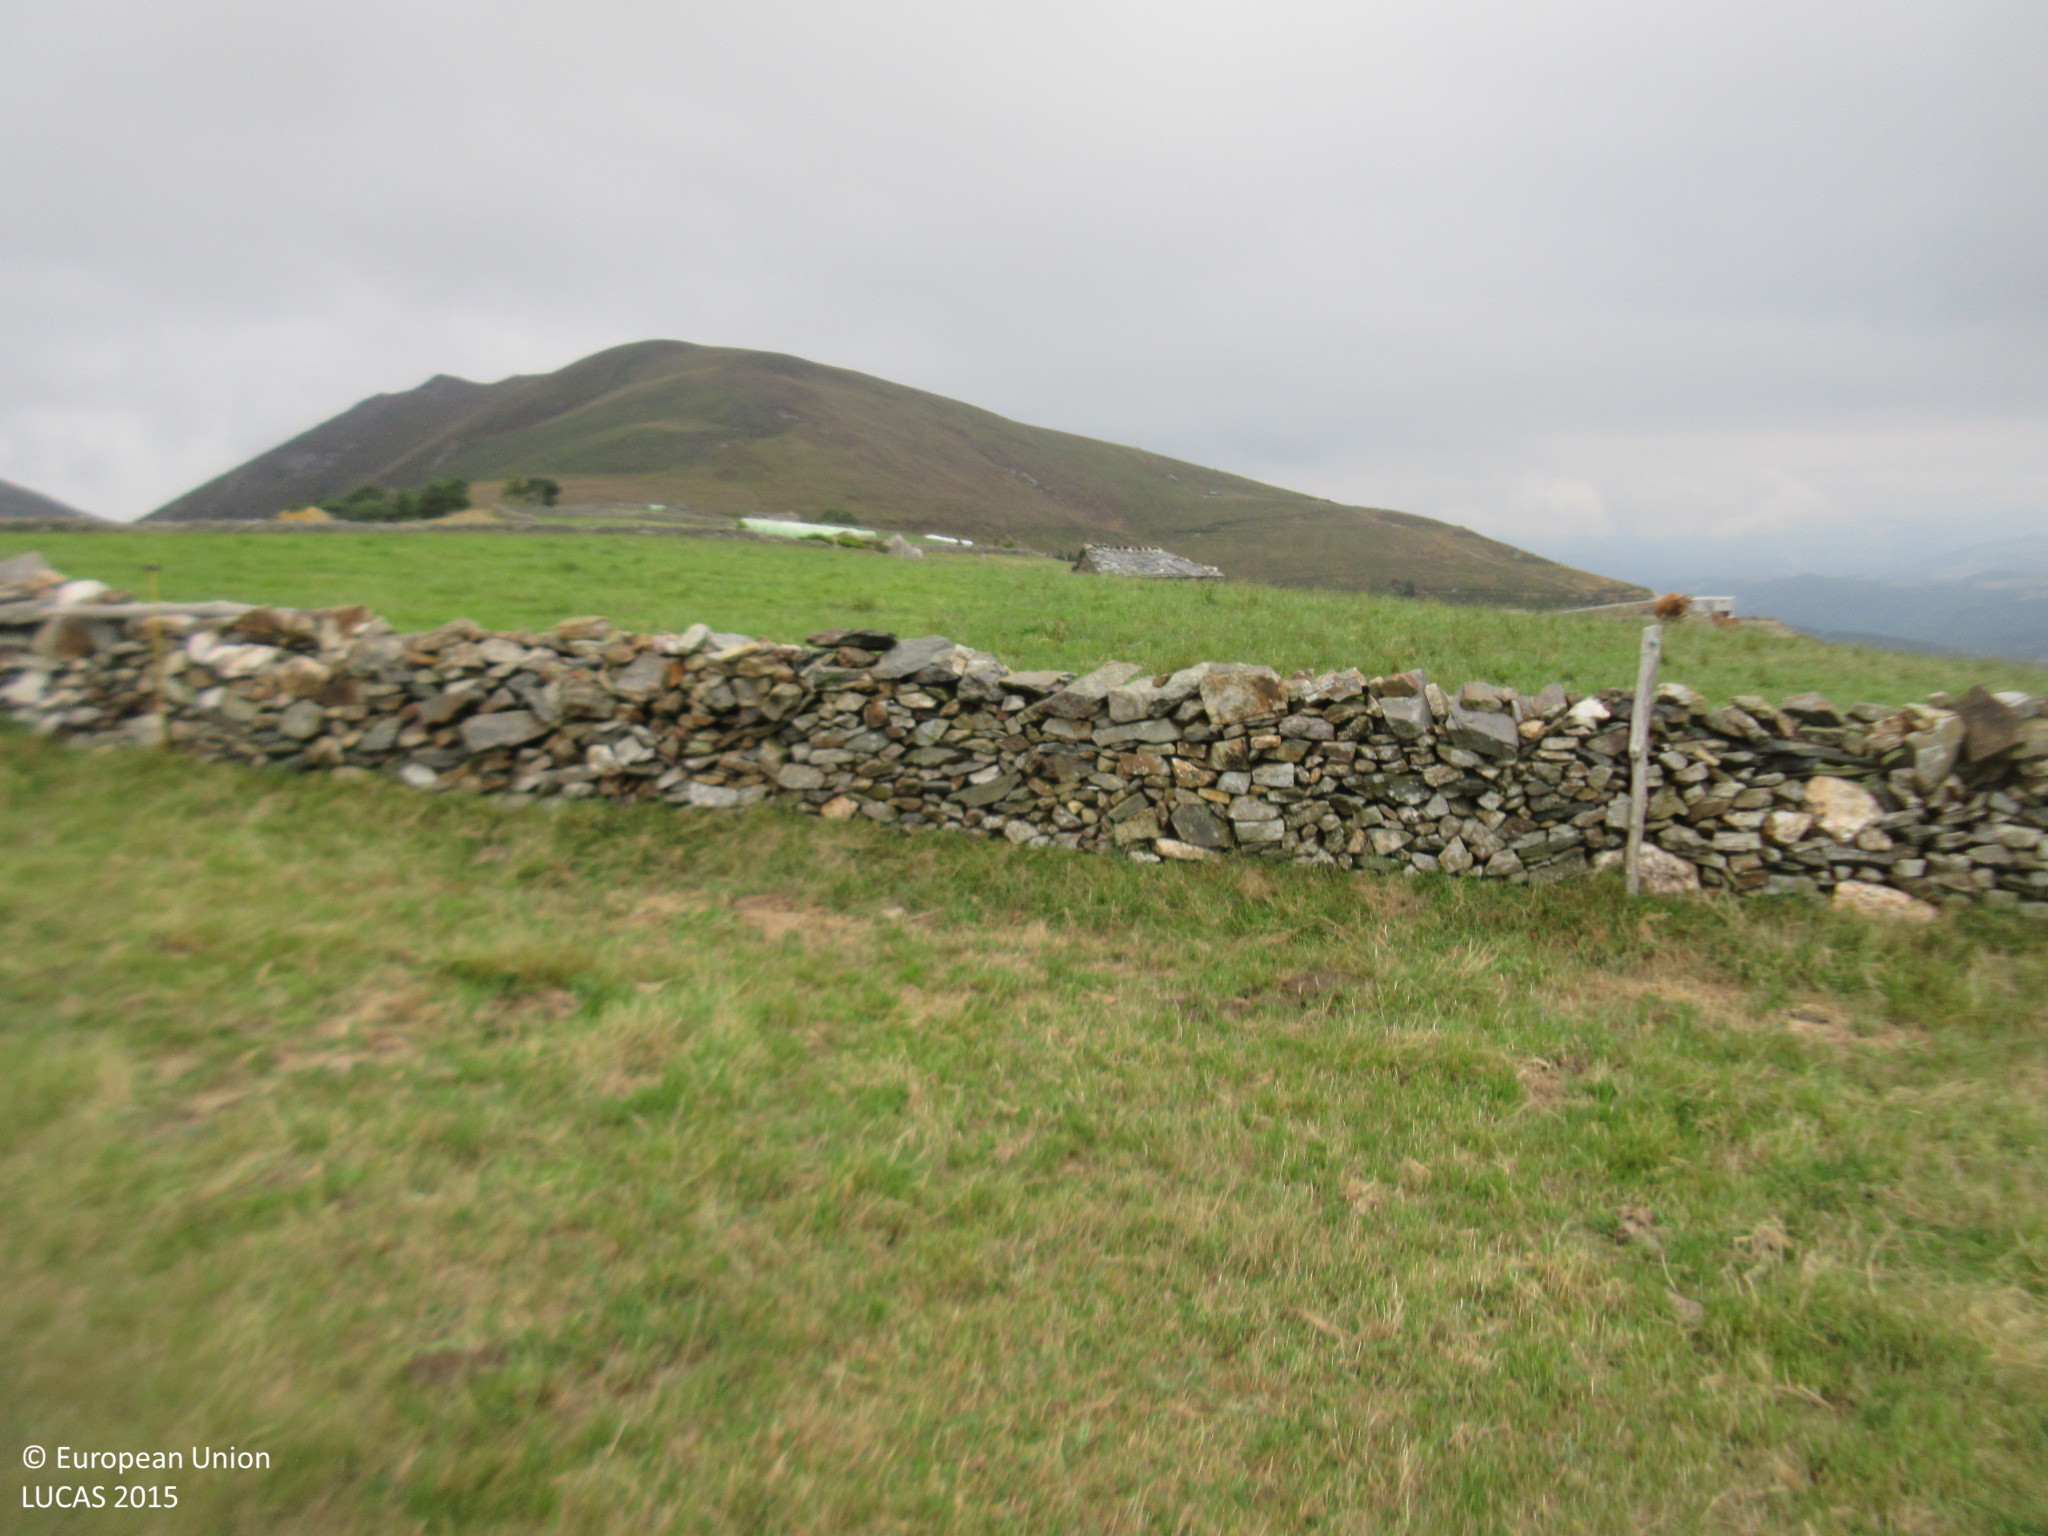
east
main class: Grassland
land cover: Grassland without tree/shrub cover
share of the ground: > 75 %
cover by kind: herbaceous plants 100 %
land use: Agriculture (excluding fallow land and kitchen gardens)
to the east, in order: Grassland without tree/shrub cover; Dry stone walls; Grassland without tree/shrub cover; Artificial constructions in urban areas; Grassland without tree/shrub cover; Dry stone walls; Tracks; Dry stone walls; Grassland without tree/shrub cover
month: August
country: ES
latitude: 43.4256
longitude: -6.5965
